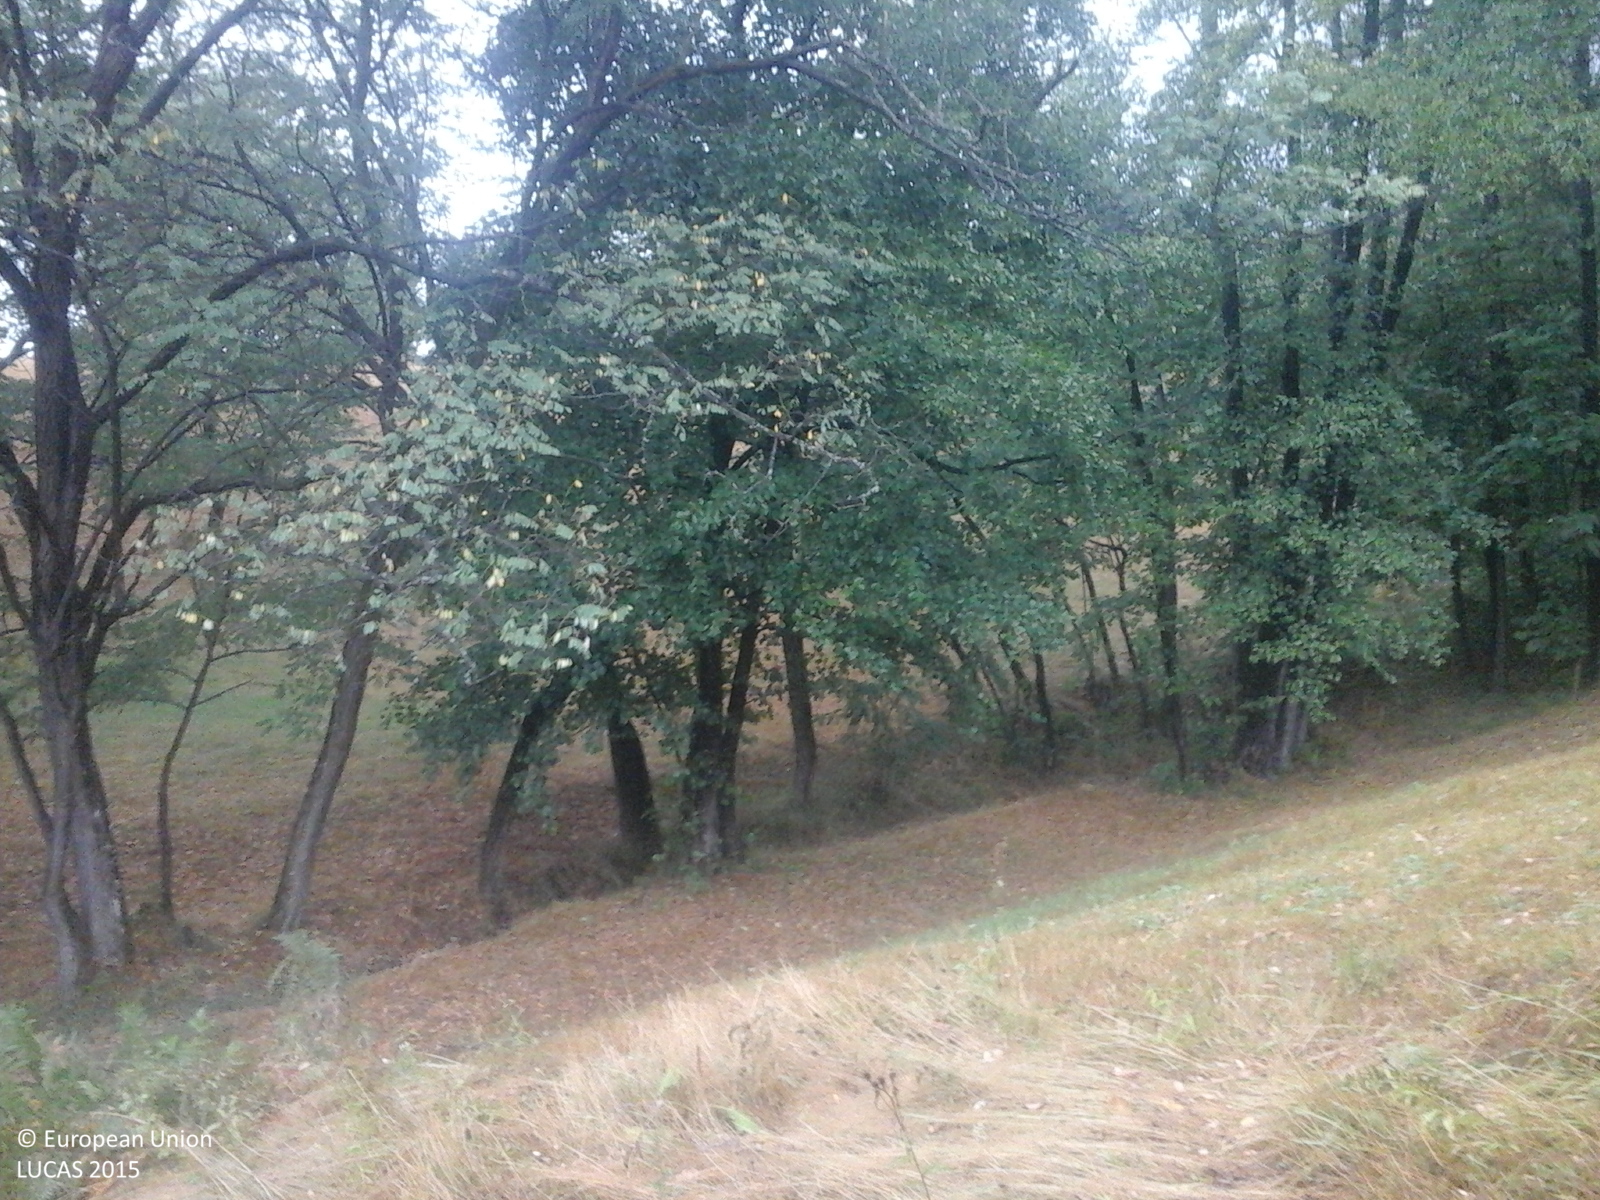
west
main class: Grassland
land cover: Grassland without tree/shrub cover
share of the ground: > 75 %
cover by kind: herbaceous plants 100 %
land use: Agriculture (excluding fallow land and kitchen gardens)
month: August
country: RO
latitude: 44.9756
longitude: 22.6612
